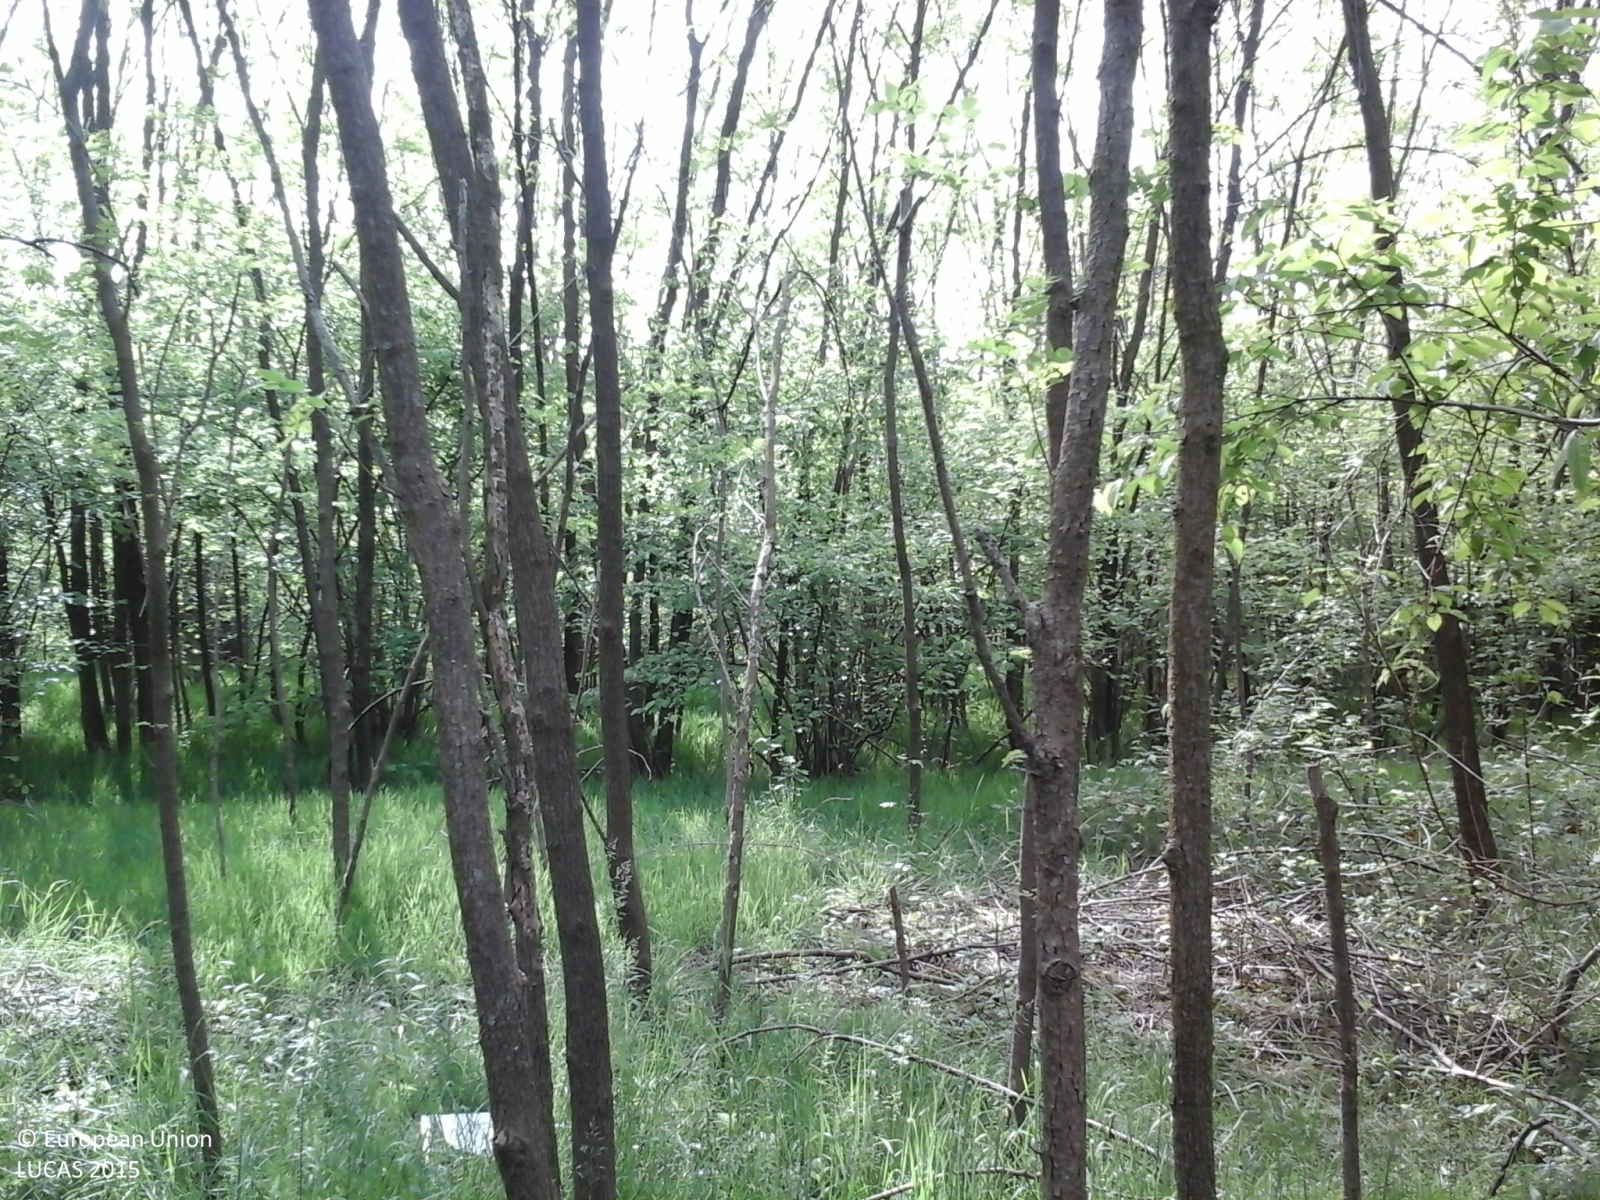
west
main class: Woodland
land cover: Broadleaved woodland
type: thermophilous deciduous forest
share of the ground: > 75 %
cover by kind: broadleaved forest trees 100 %
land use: Forestry
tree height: > 5 m
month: May
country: IT
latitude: 45.6556
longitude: 8.4753
